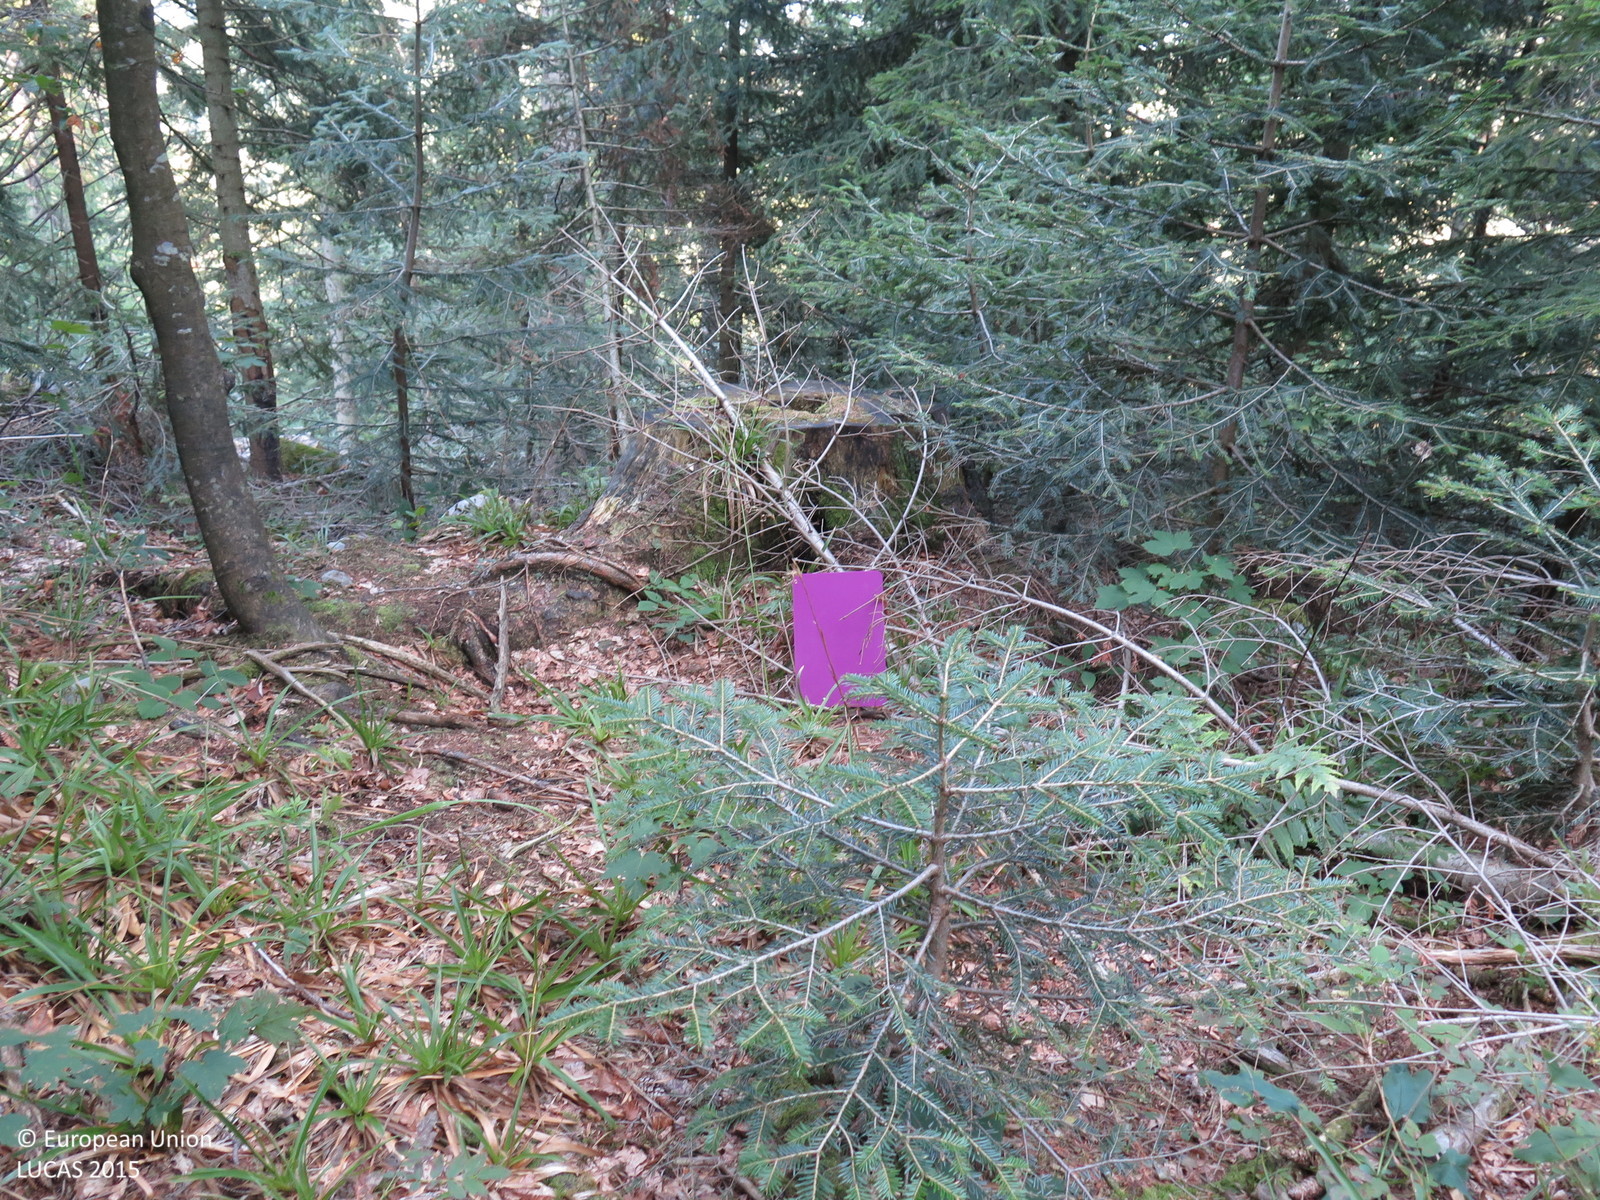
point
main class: Woodland
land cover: Other mixed woodland
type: mountainous beech forest
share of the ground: > 75 %
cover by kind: coniferous forest trees 75 %, broadleaved forest trees 25 %
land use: Forestry
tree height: > 5 m
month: August
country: HR
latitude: 45.3325
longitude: 14.9843
